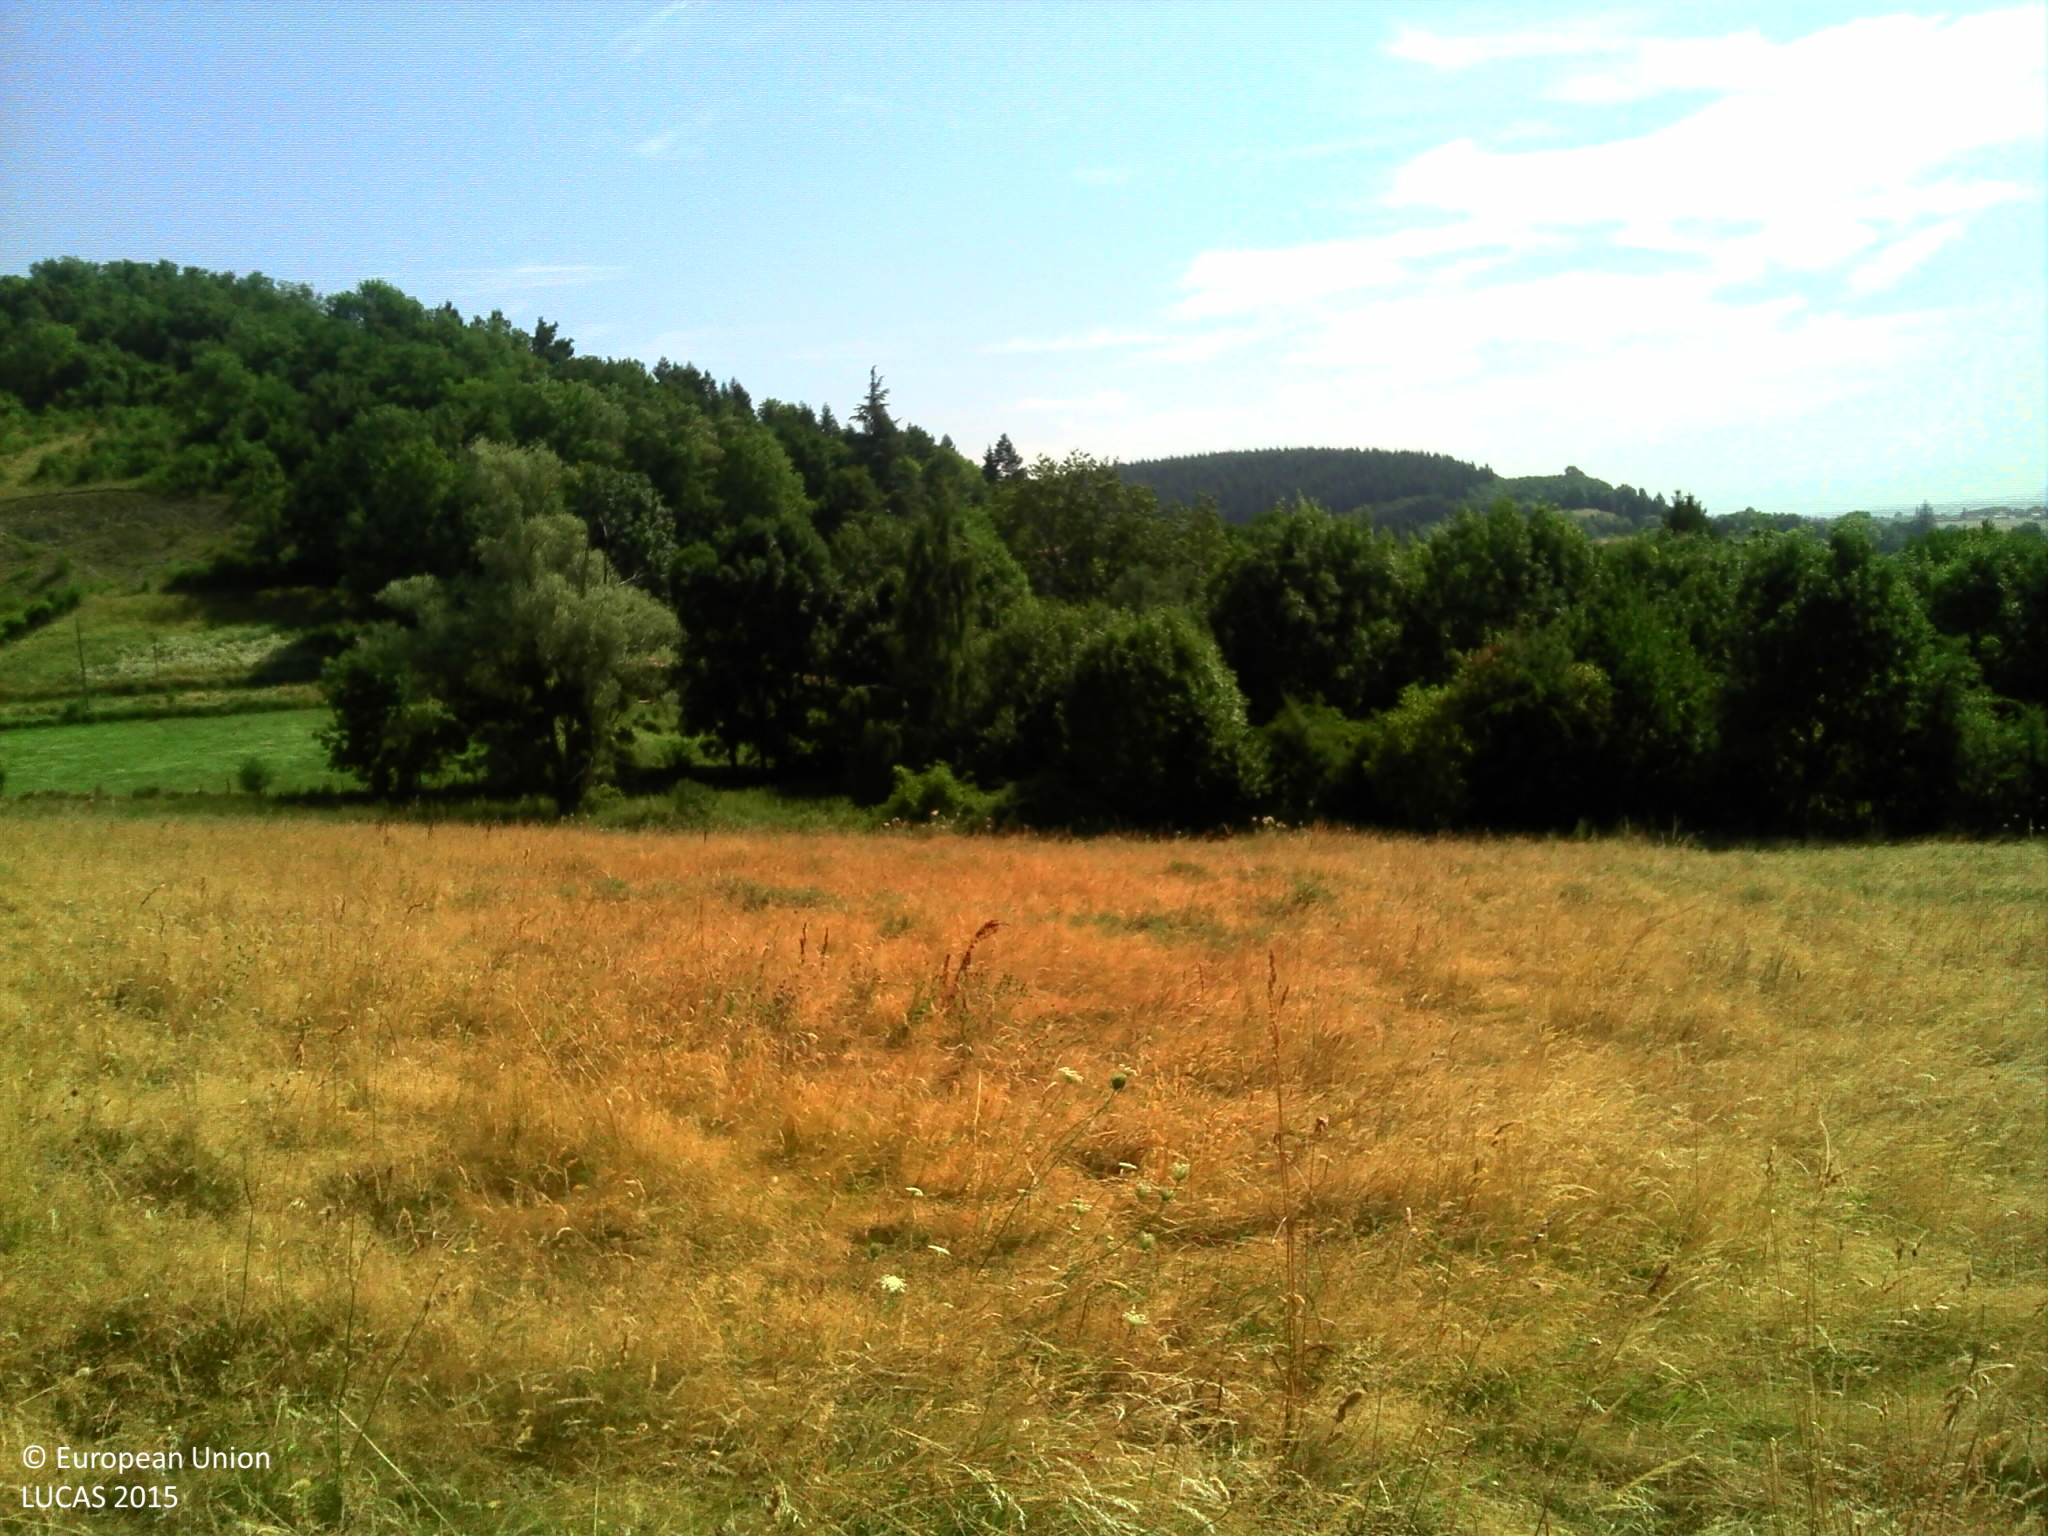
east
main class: Grassland
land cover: Grassland without tree/shrub cover
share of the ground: > 75 %
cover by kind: herbaceous plants 100 %
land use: Agriculture (excluding fallow land and kitchen gardens)
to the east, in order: Grassland without tree/shrub cover; Fences; Abandoned hedges; Grass margins; Broadleaved woodland; Grassland without tree/shrub cover; Inland fresh water bodies; Grassland without tree/shrub cover; Broadleaved woodland; Fences; Grassland without tree/shrub cover
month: July
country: FR
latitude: 45.4307
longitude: 5.1858
